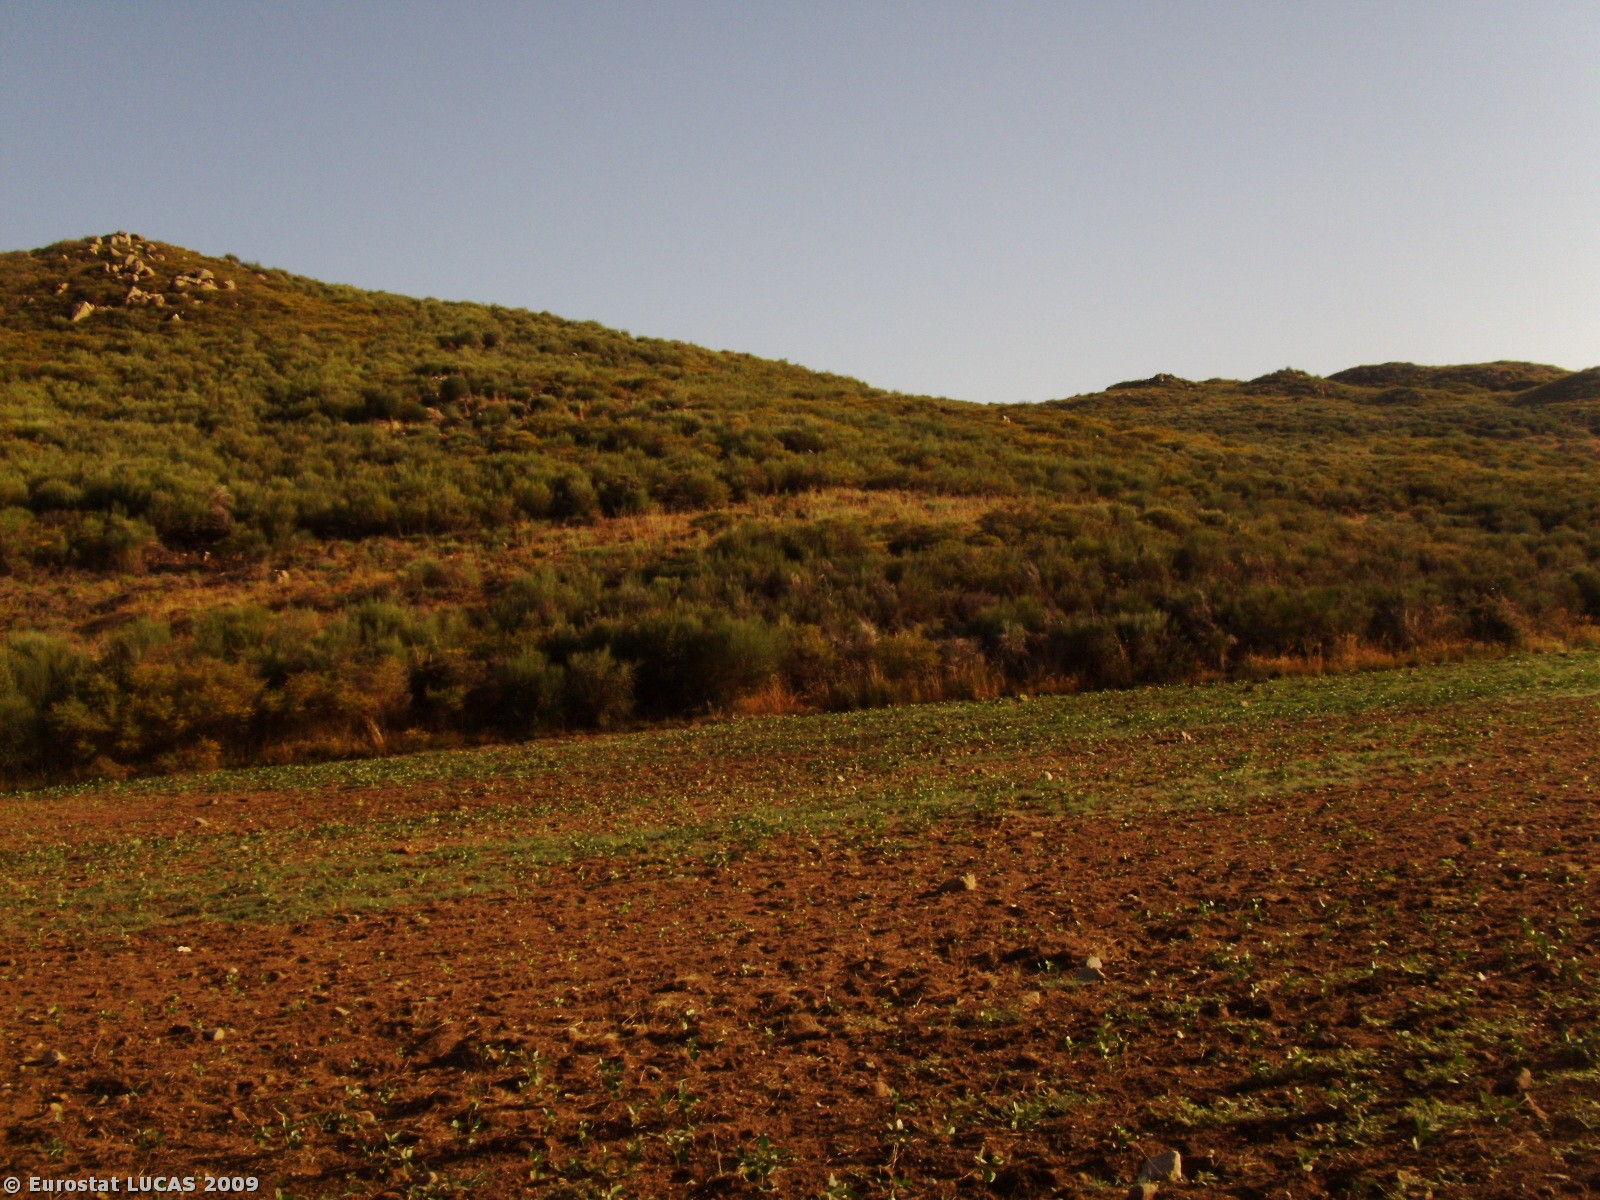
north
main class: Cropland
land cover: Other leguminous and mixtures for fodder
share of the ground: 25 - 50 %
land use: Agriculture (excluding fallow land and kitchen gardens)
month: June
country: PT
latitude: 39.9901
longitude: -7.3017
